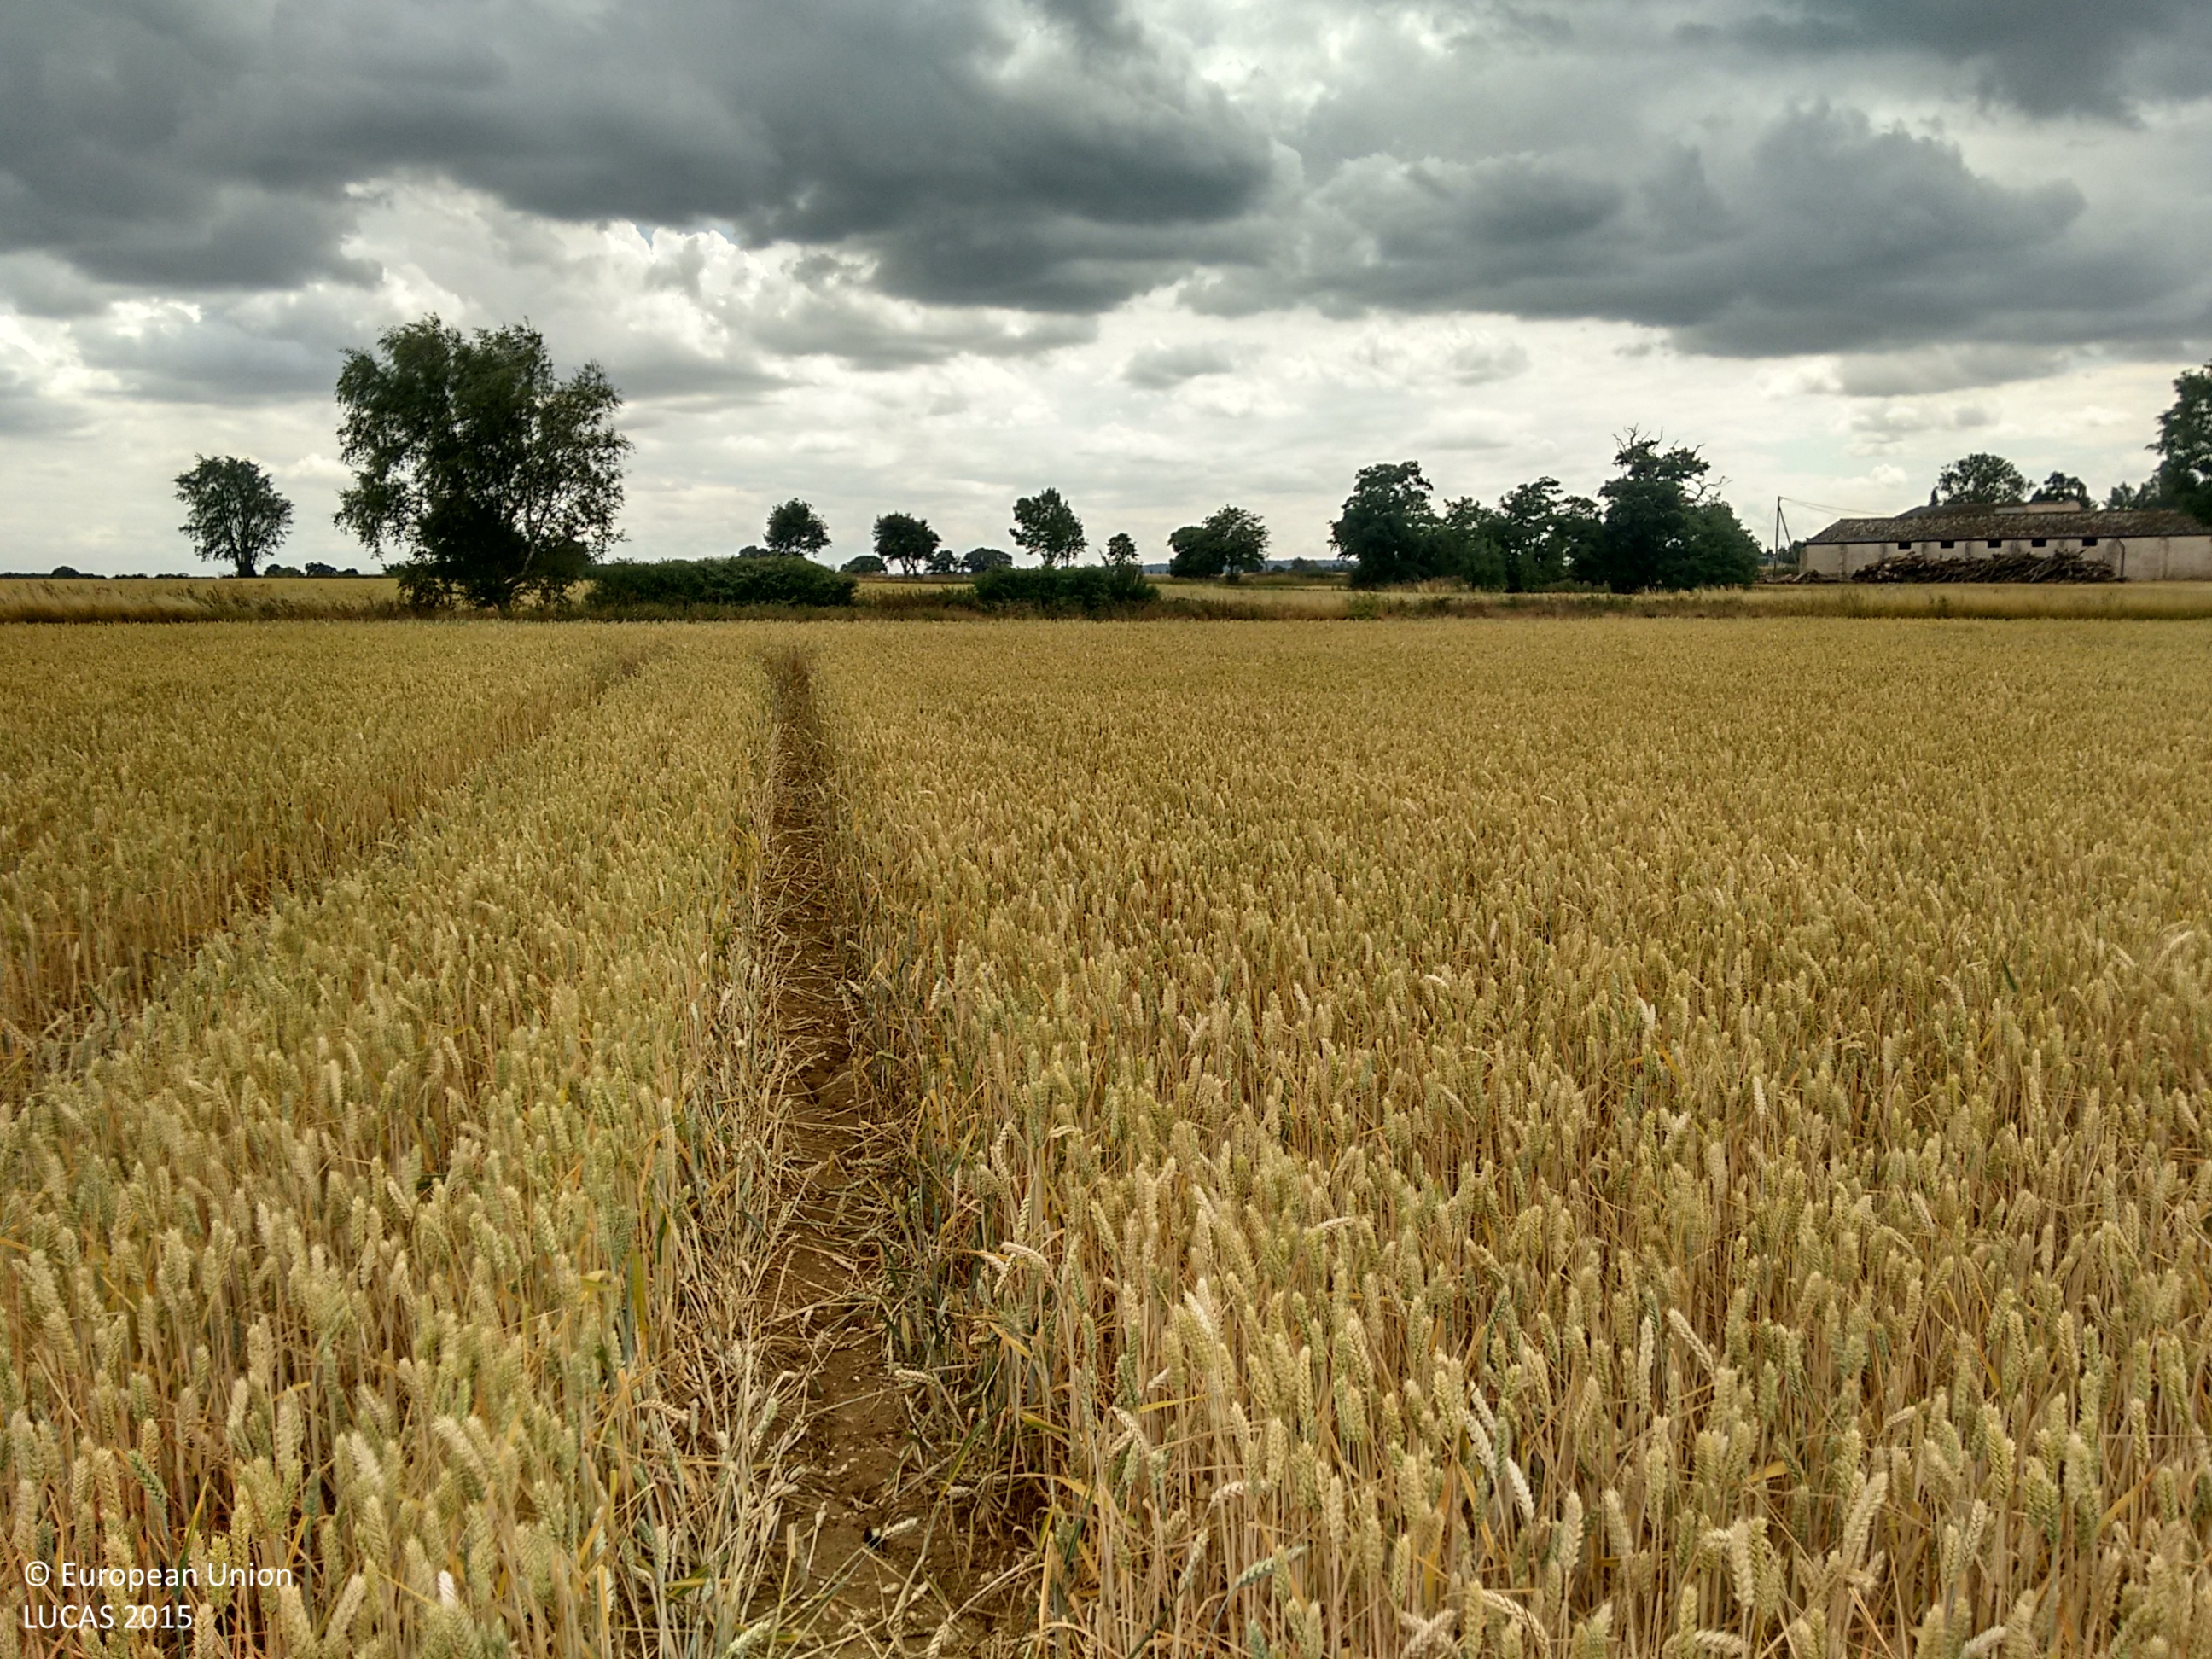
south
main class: Cropland
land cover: Common wheat
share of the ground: > 75 %
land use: Agriculture (excluding fallow land and kitchen gardens)
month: July
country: GB
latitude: 51.8038
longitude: 0.5900
